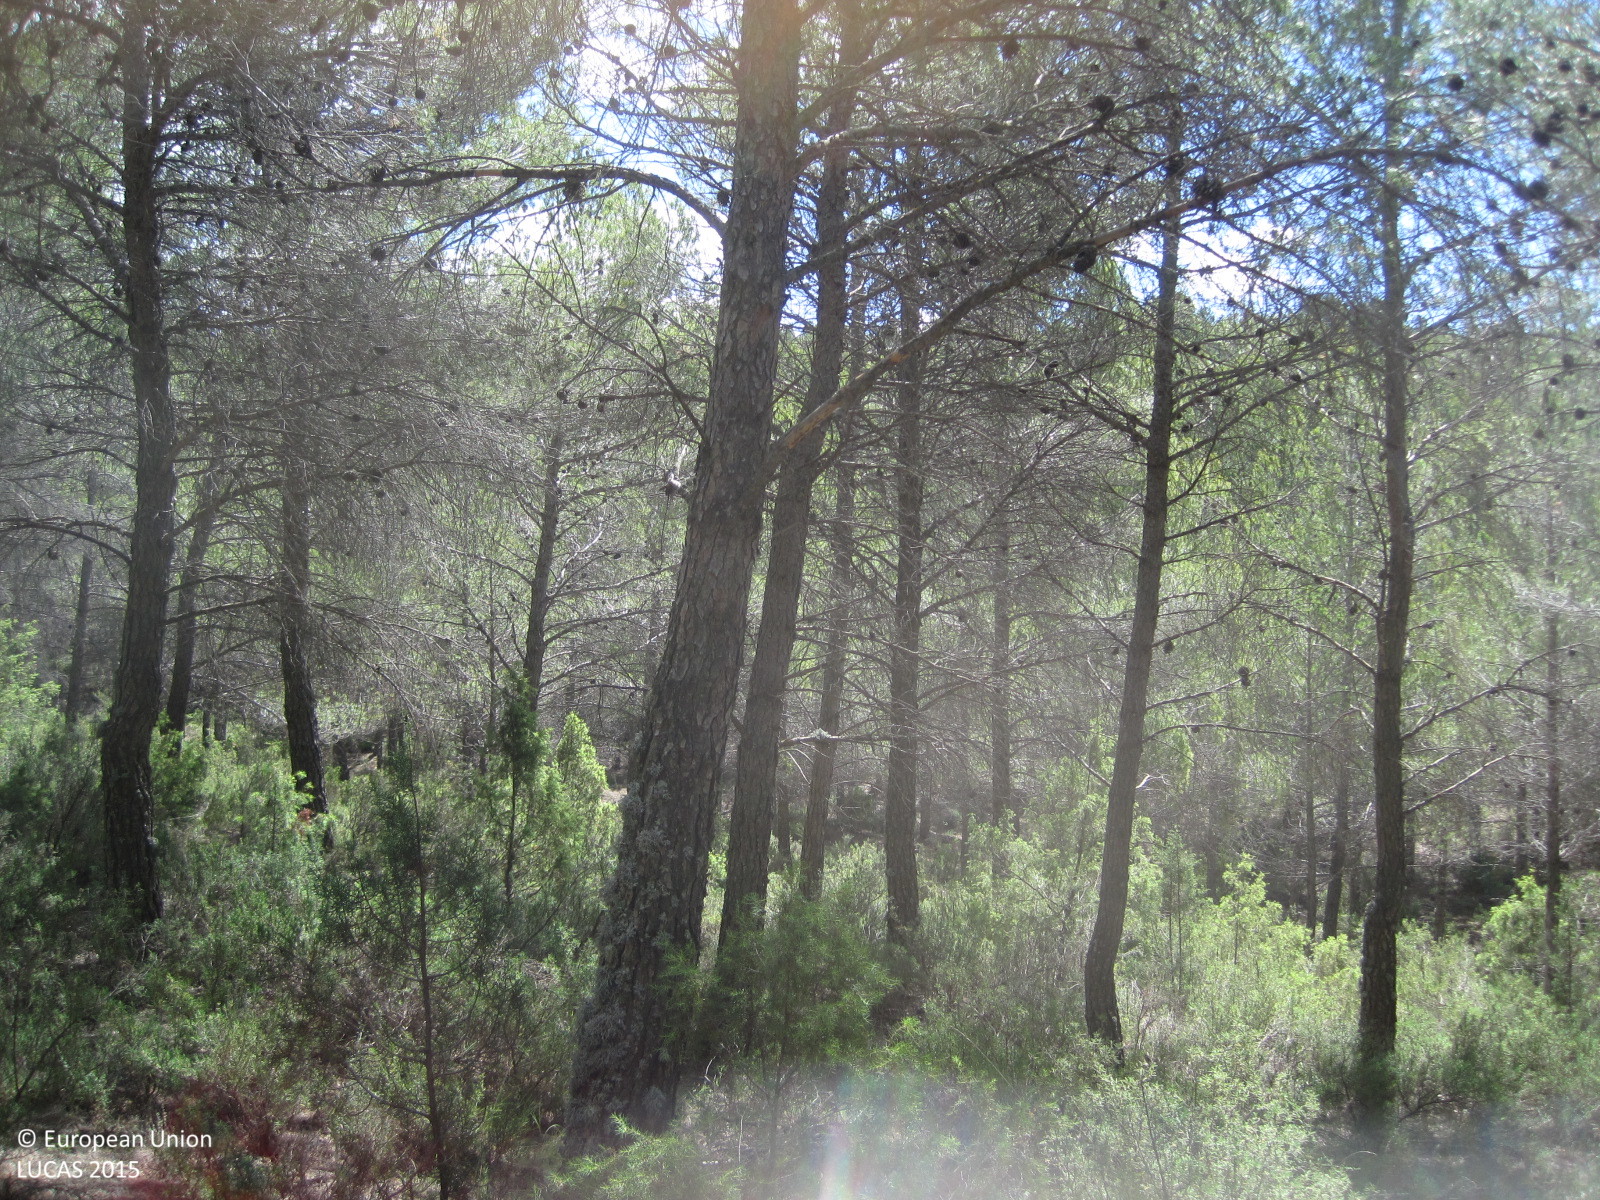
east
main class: Woodland
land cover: Pine dominated coniferous woodland
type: coniferous forest of the mediterranean region
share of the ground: > 75 %
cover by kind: coniferous forest trees 80 %, shrubs 10 %, herbaceous plants 10 %
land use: Forestry
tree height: > 5 m
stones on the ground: 25 - 50 %
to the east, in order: Pine dominated coniferous woodland; Shrubland with sparse tree cover
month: June
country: ES
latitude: 39.8935
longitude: -0.9162
